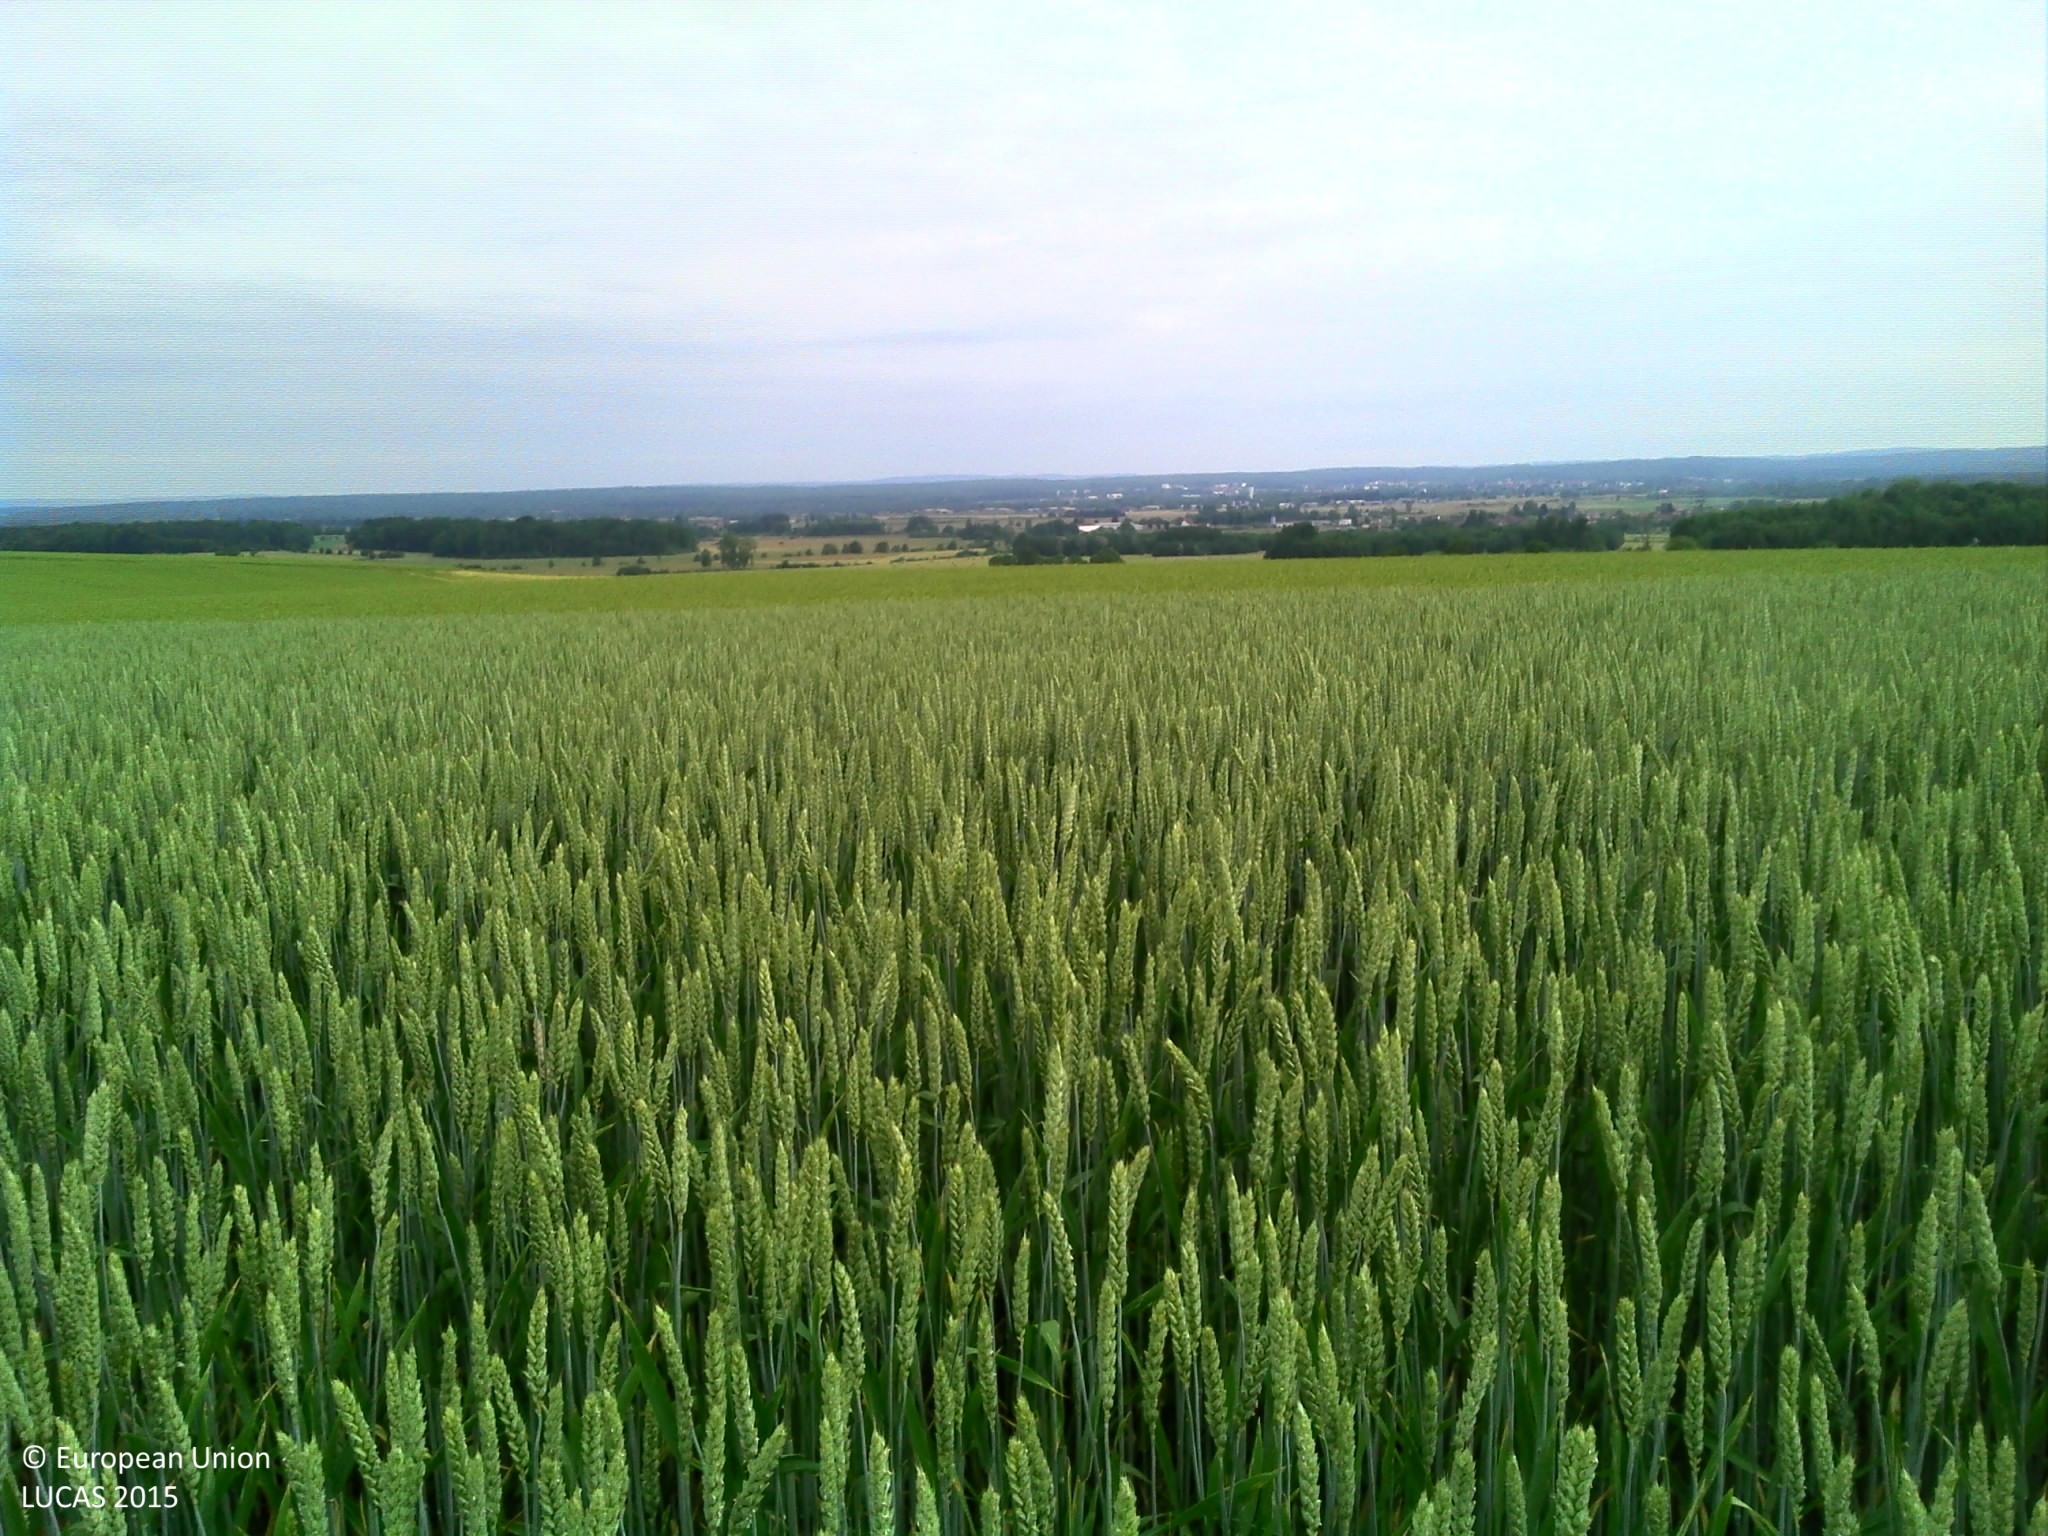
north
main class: Cropland
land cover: Common wheat
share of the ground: > 75 %
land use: Agriculture (excluding fallow land and kitchen gardens)
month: June
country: FR
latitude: 47.7491
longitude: 6.3599
